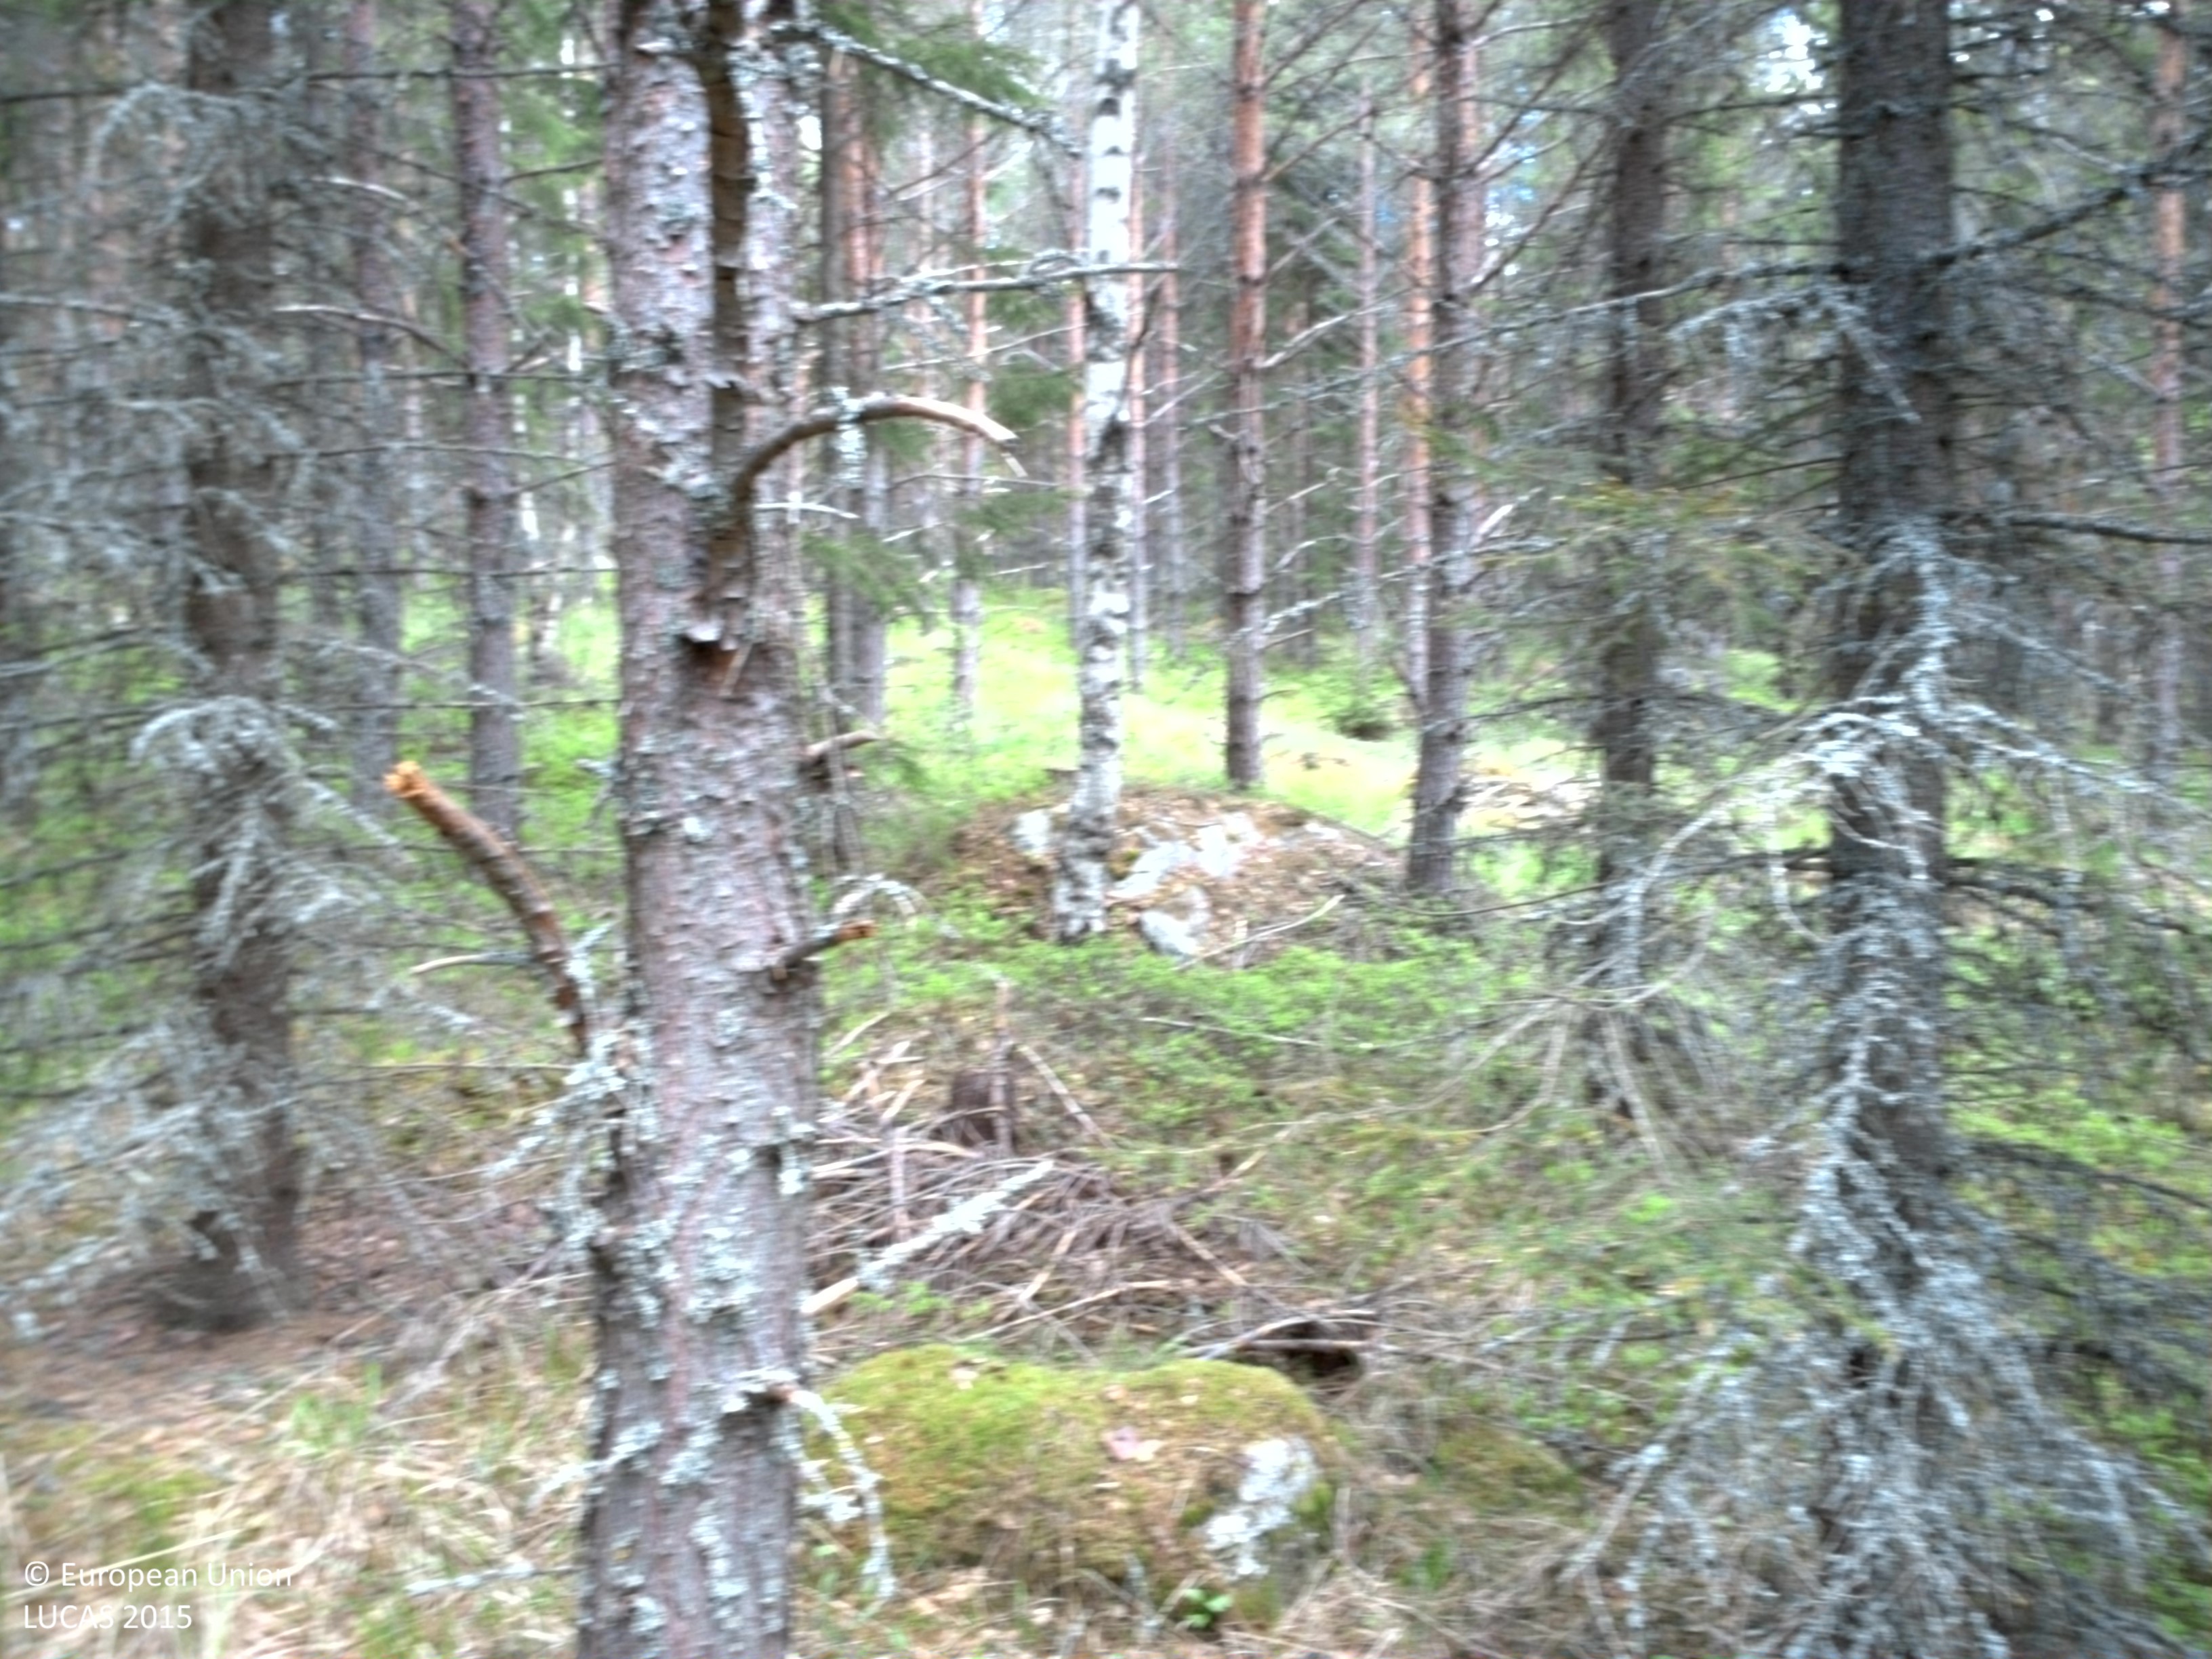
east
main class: Woodland
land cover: Pine dominated coniferous woodland
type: boreal forest
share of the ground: 50 - 75 %
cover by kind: coniferous forest trees 65 %, herbaceous plants 30 %, lichens and mosses 5 %
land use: Forestry
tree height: > 5 m
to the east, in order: Pine dominated coniferous woodland; Tracks; Pine dominated coniferous woodland; Pine dominated mixed woodland
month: May
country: SE
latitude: 61.2822
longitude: 15.5258
